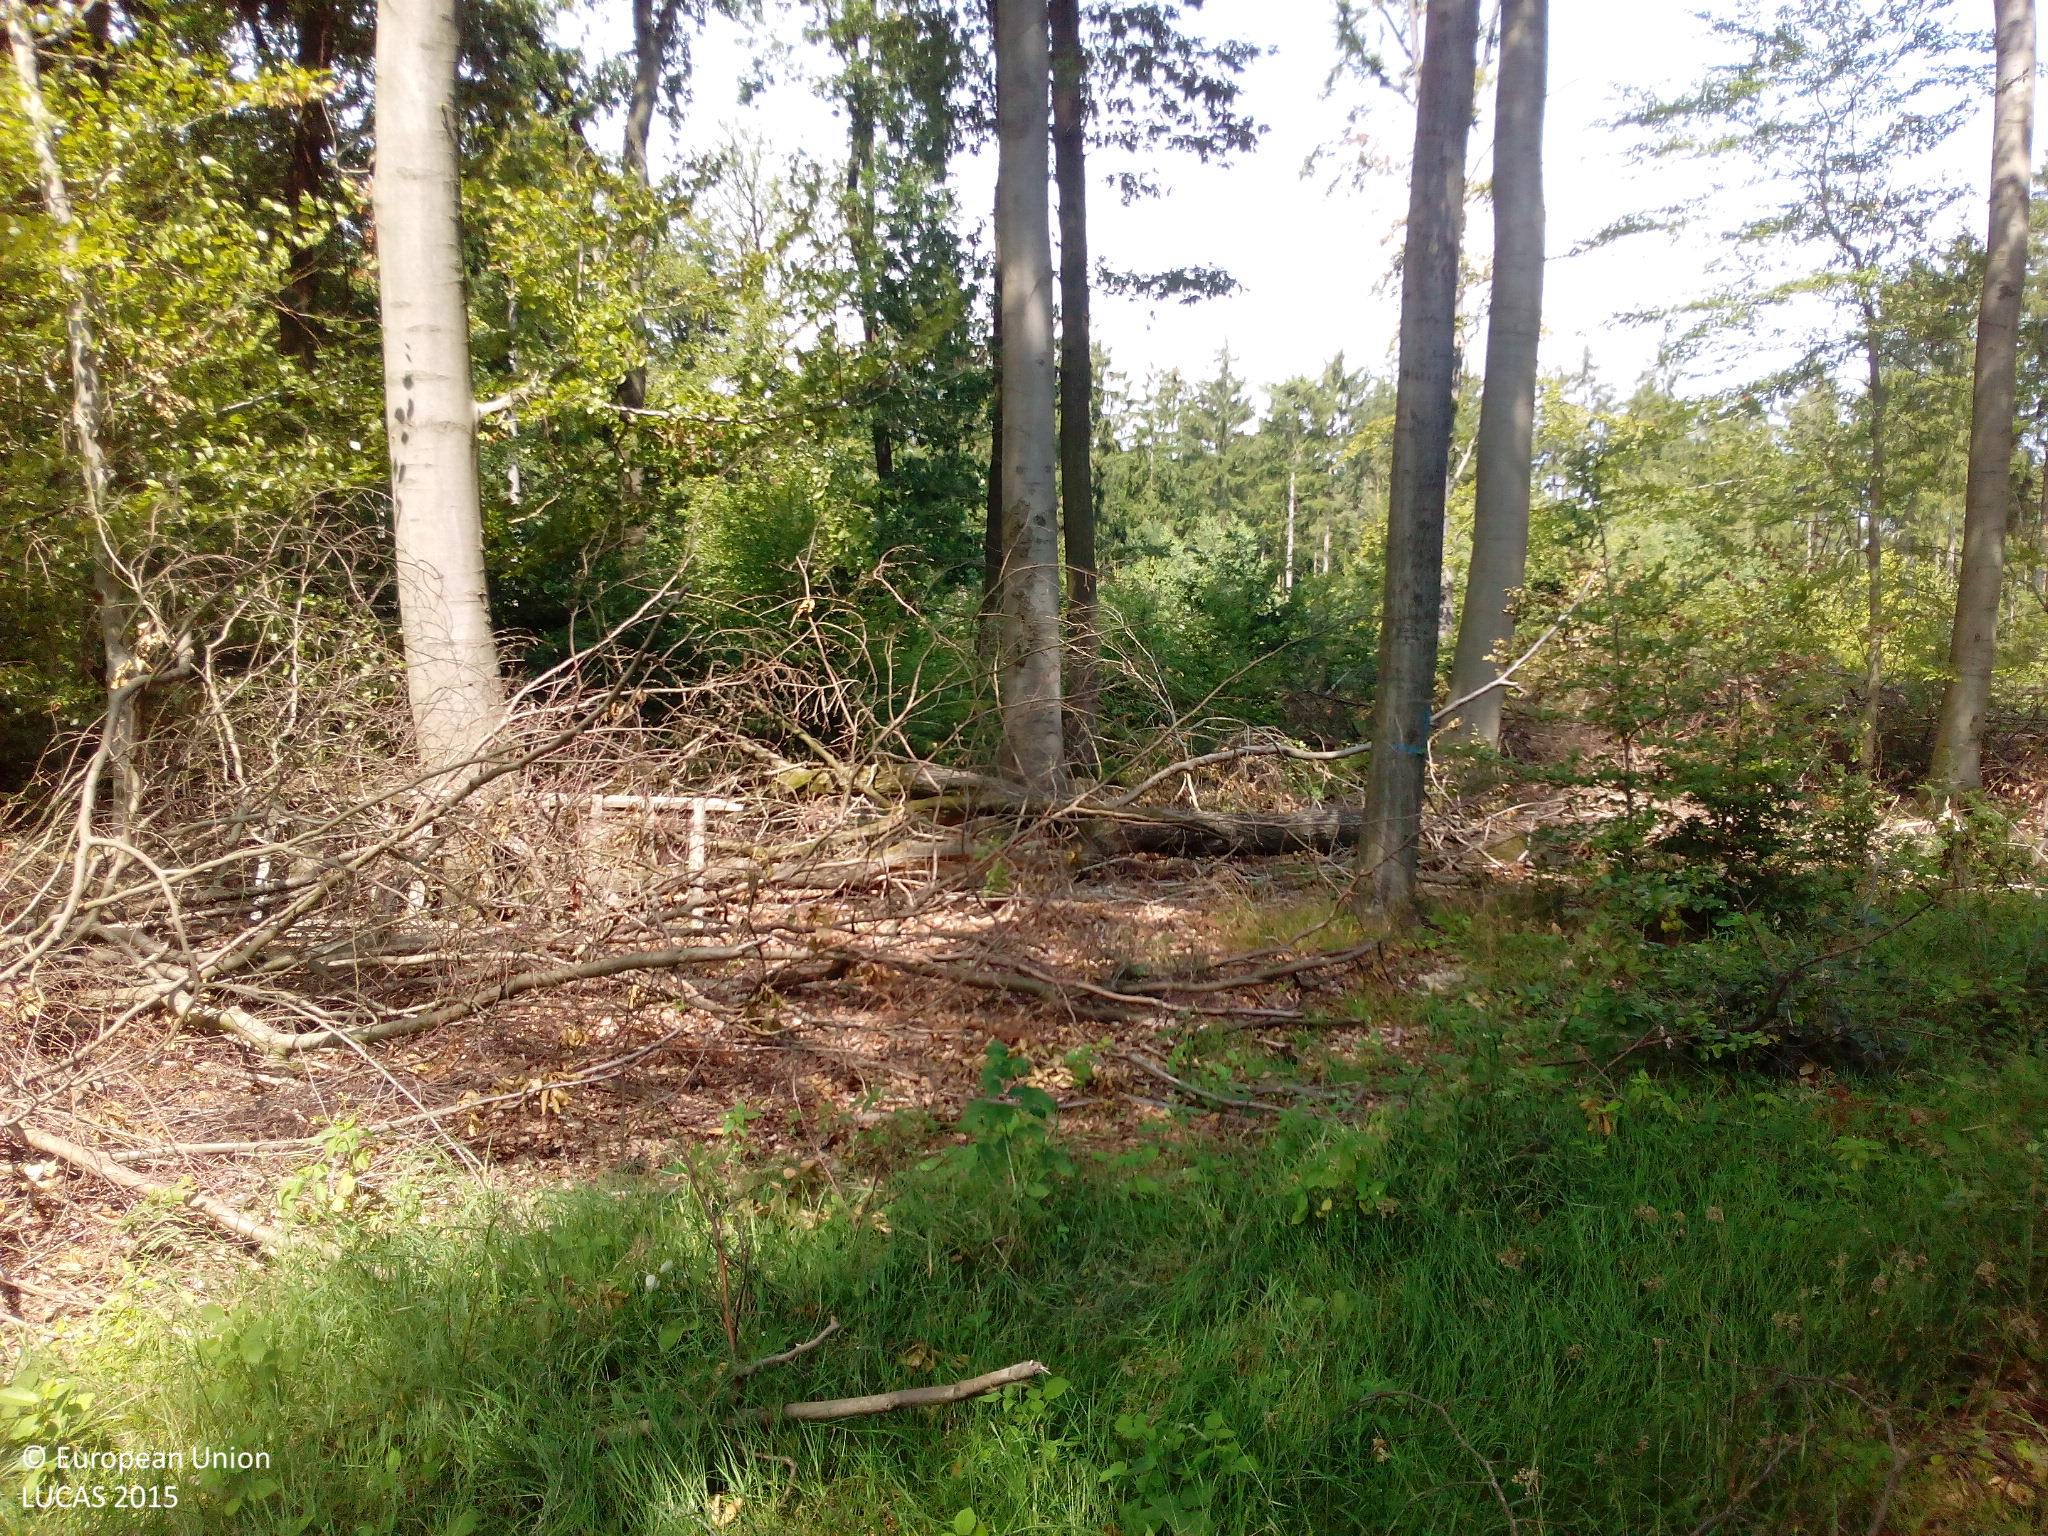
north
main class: Woodland
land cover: Broadleaved woodland
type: beech forest
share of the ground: > 75 %
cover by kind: broadleaved forest trees 90 %, herbaceous plants 10 %
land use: Forestry
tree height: < 5 m
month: August
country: DE
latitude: 52.0877
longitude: 9.2851
